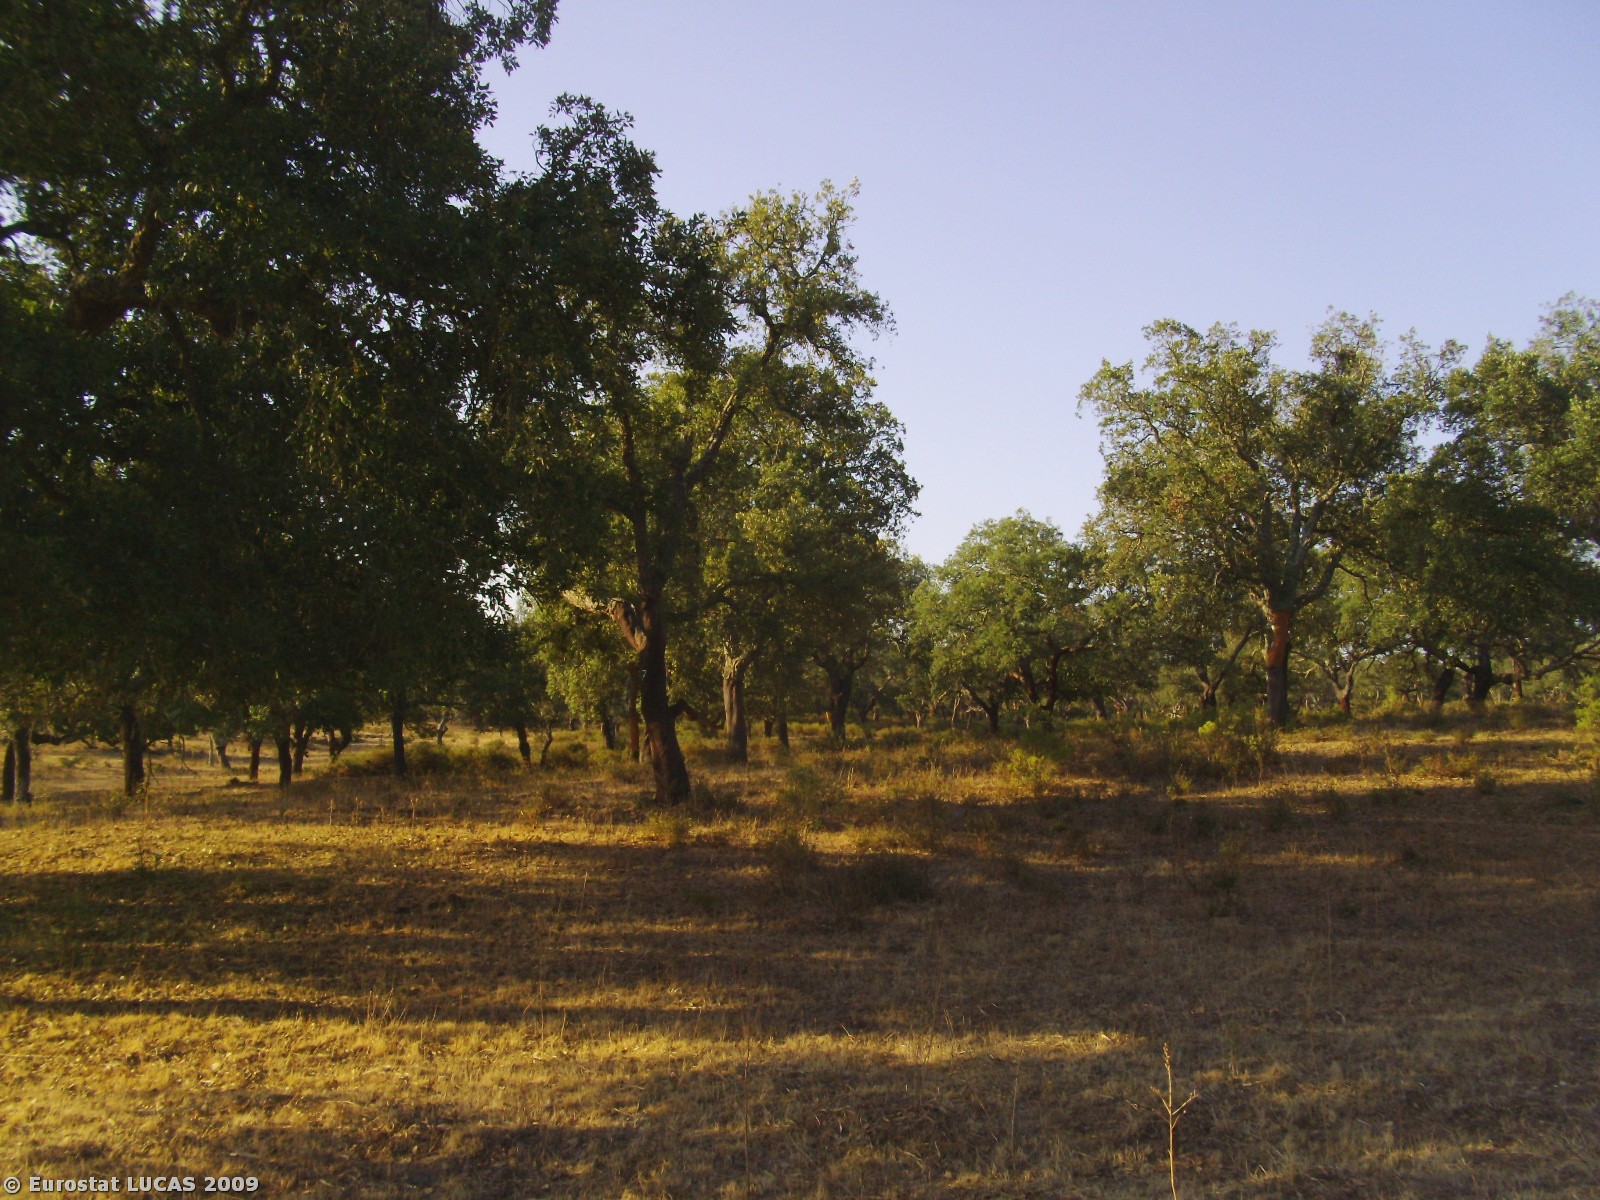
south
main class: Woodland
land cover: Broadleaved woodland
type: broadleaved evergreen forest
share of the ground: 25 - 50 %
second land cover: Spontaneously vegetated surfaces
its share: 25 - 50 %
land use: Forestry
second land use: Fallow land
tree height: > 5 m
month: August
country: PT
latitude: 38.0301
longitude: -8.4879
